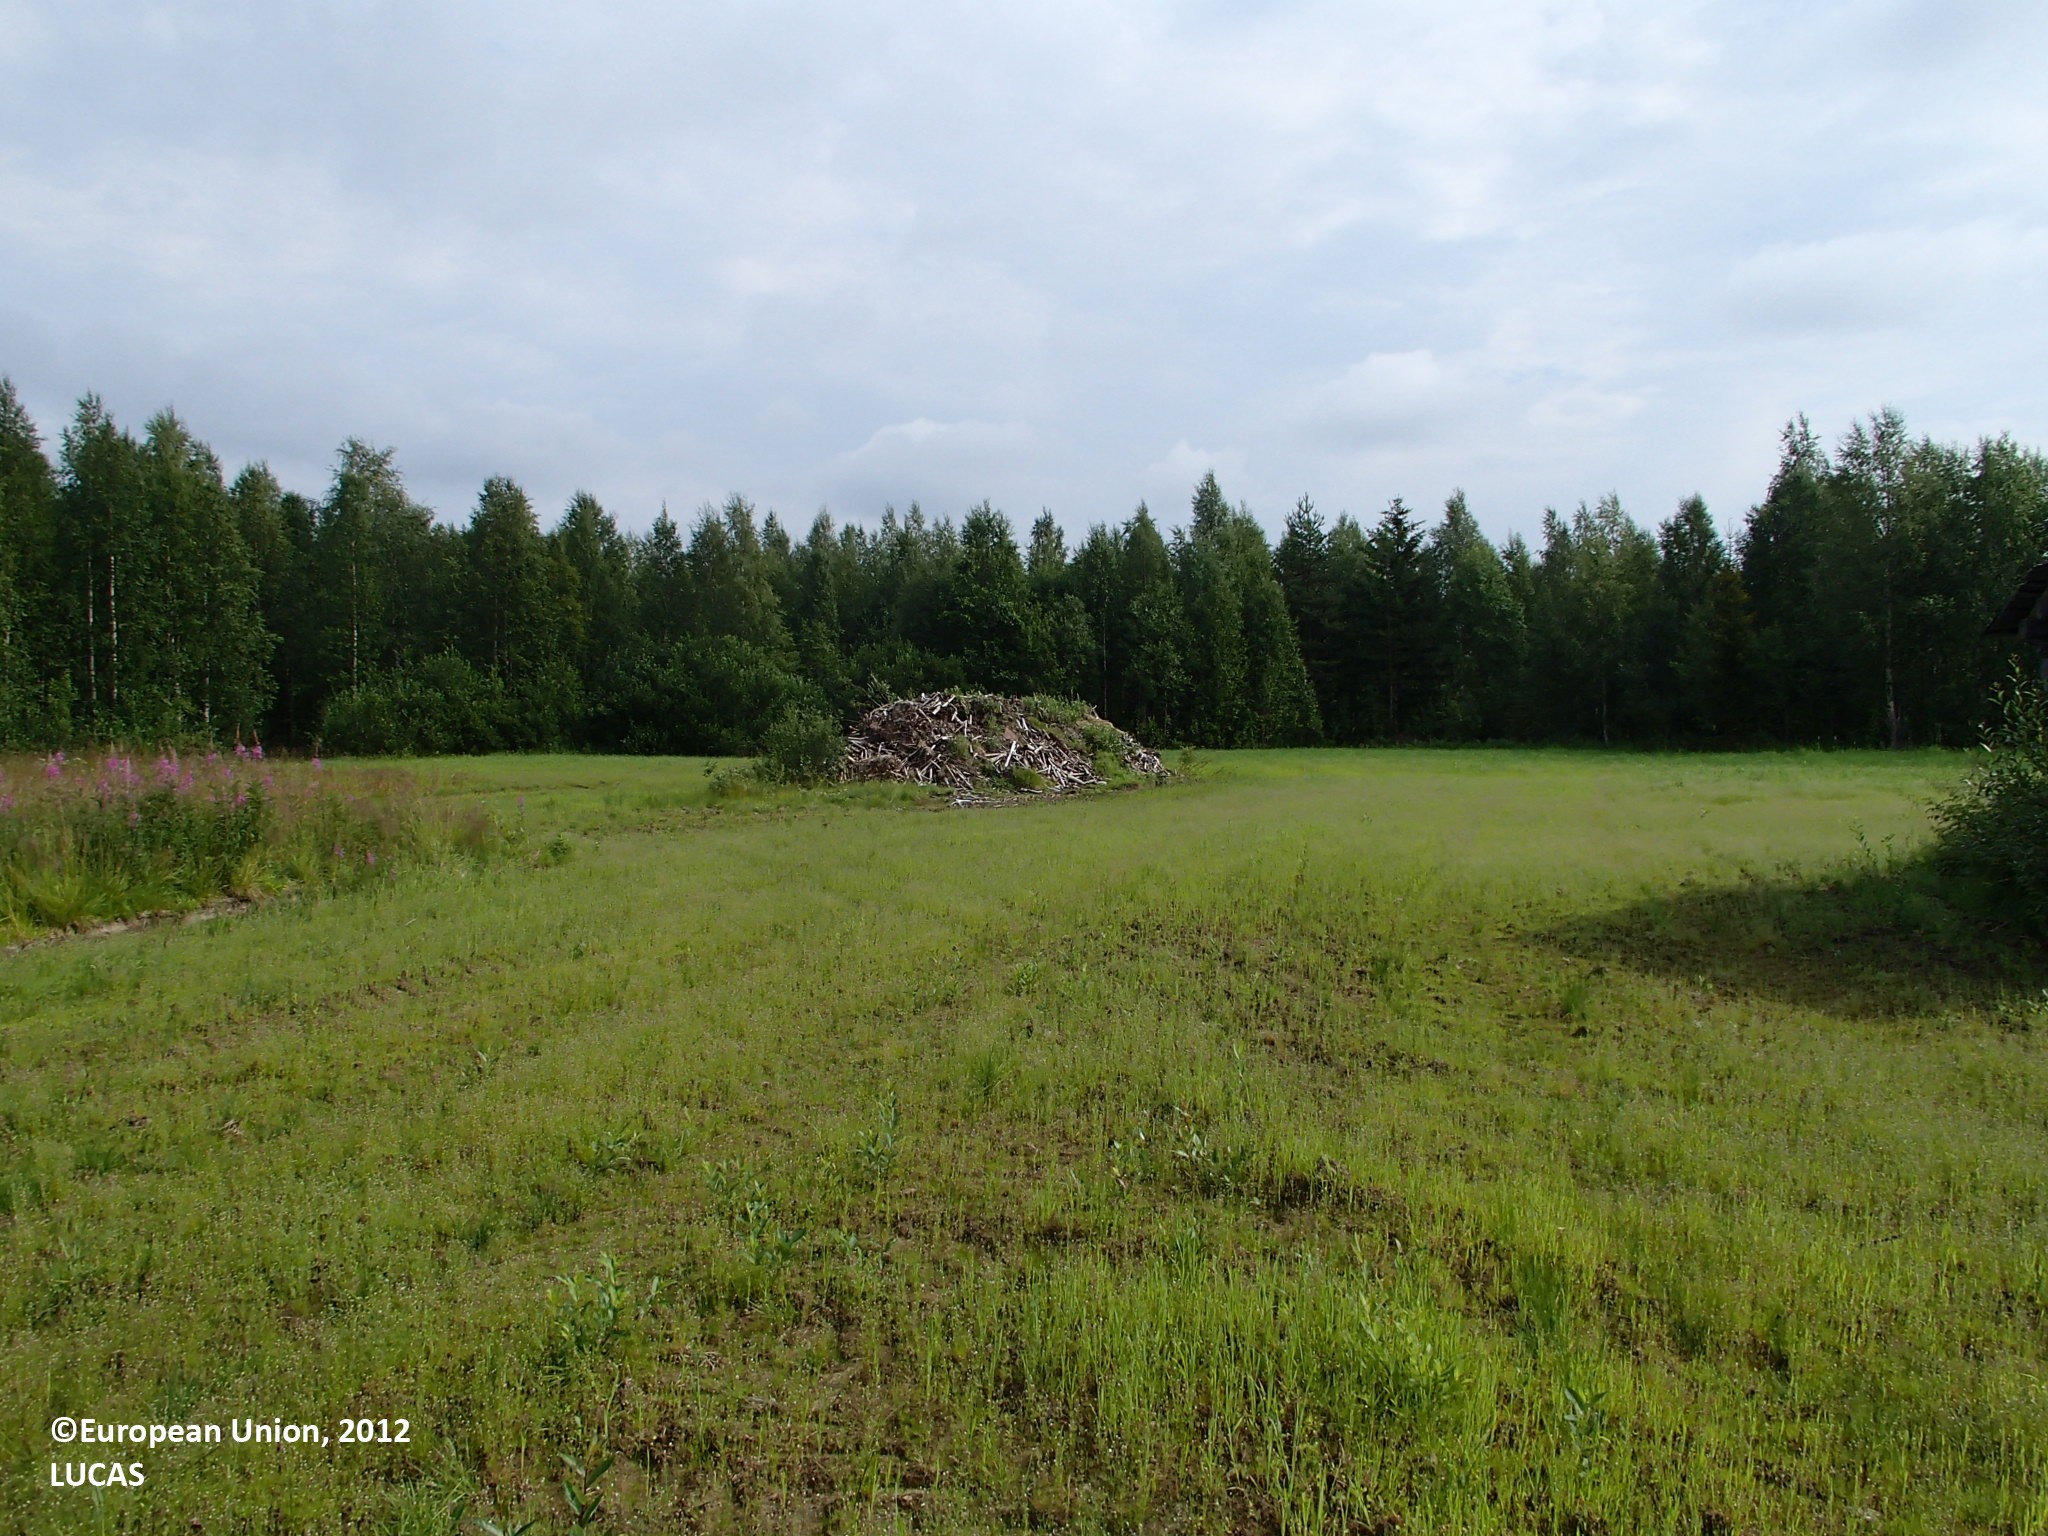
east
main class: Cropland
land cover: Temporary grasslands
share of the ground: 50 - 75 %
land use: Agriculture (excluding fallow land and kitchen gardens)
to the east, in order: Temporary grasslands; Broadleaved woodland; Ditches and canals; Other mixed woodland; Broadleaved woodland; Inland running water; Other mixed woodland
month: July
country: FI
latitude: 66.1829
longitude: 25.3104
